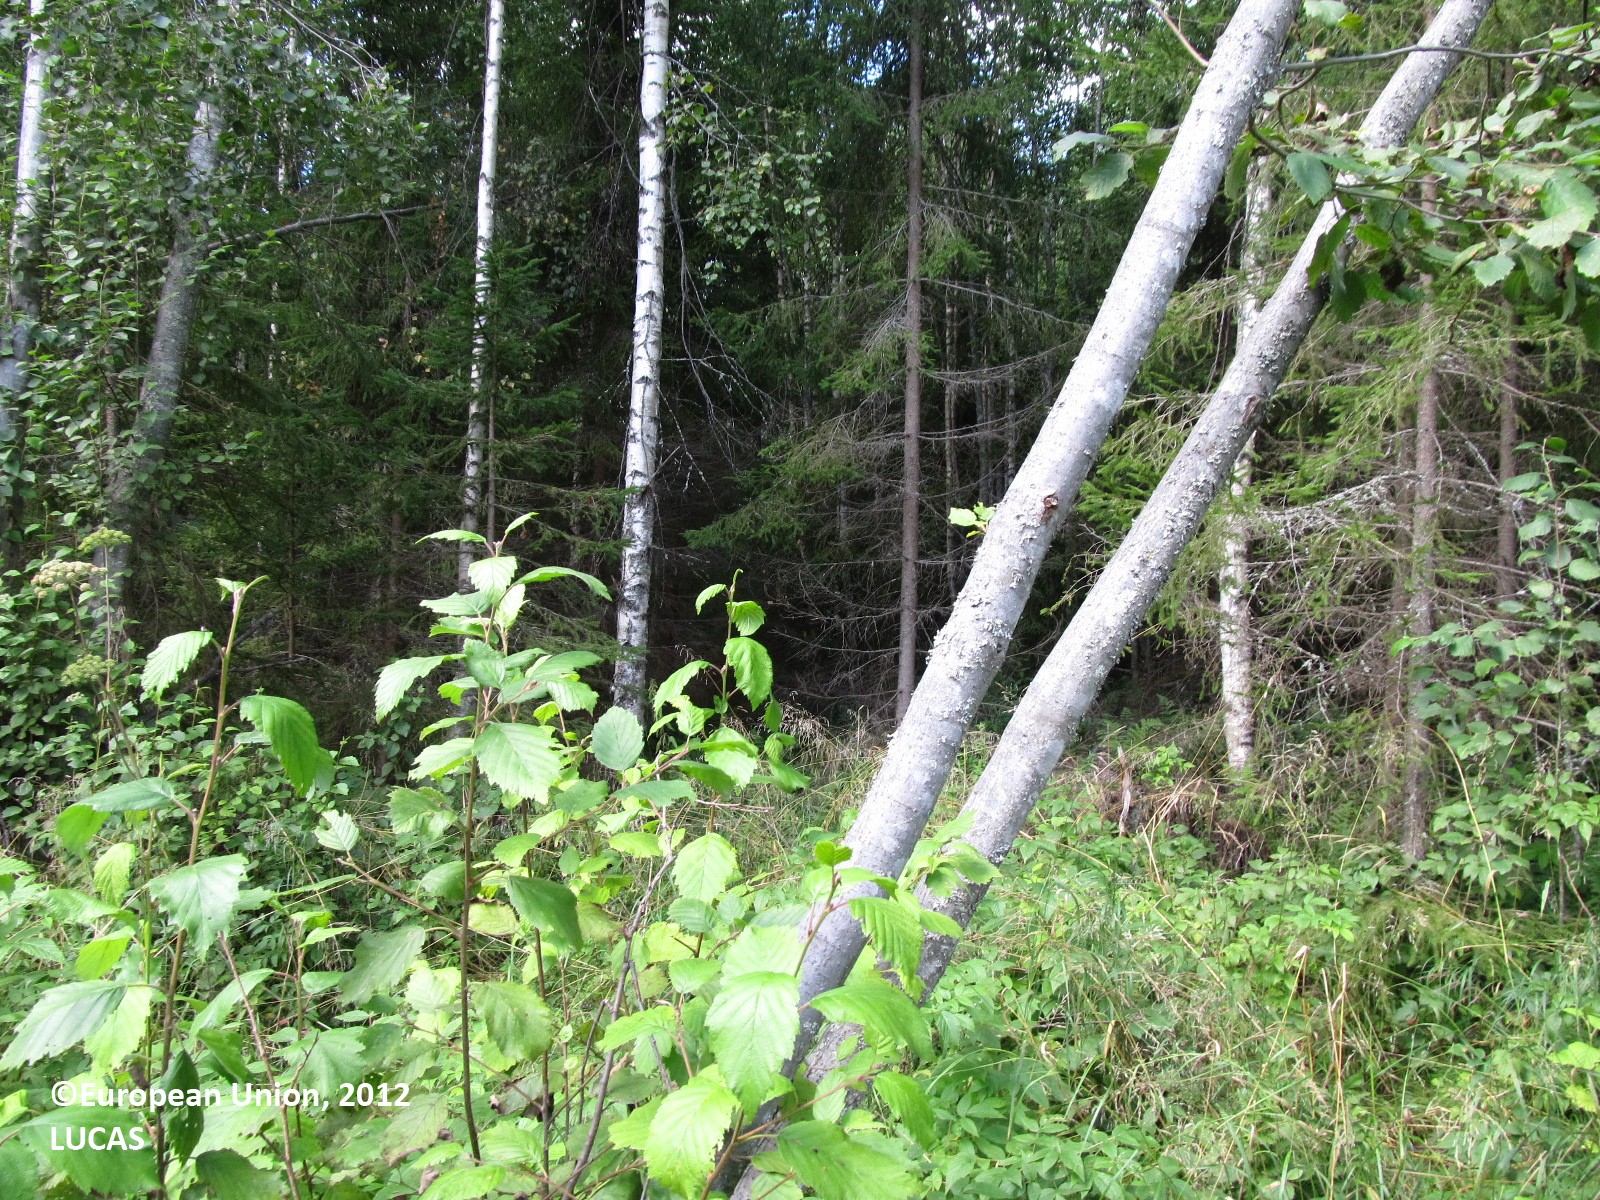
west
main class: Woodland
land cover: Spruce dominated mixed woodland
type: boreal forest
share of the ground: 25 - 50 %
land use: Forestry
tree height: > 5 m
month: August
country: FI
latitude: 62.2367
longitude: 27.5482
